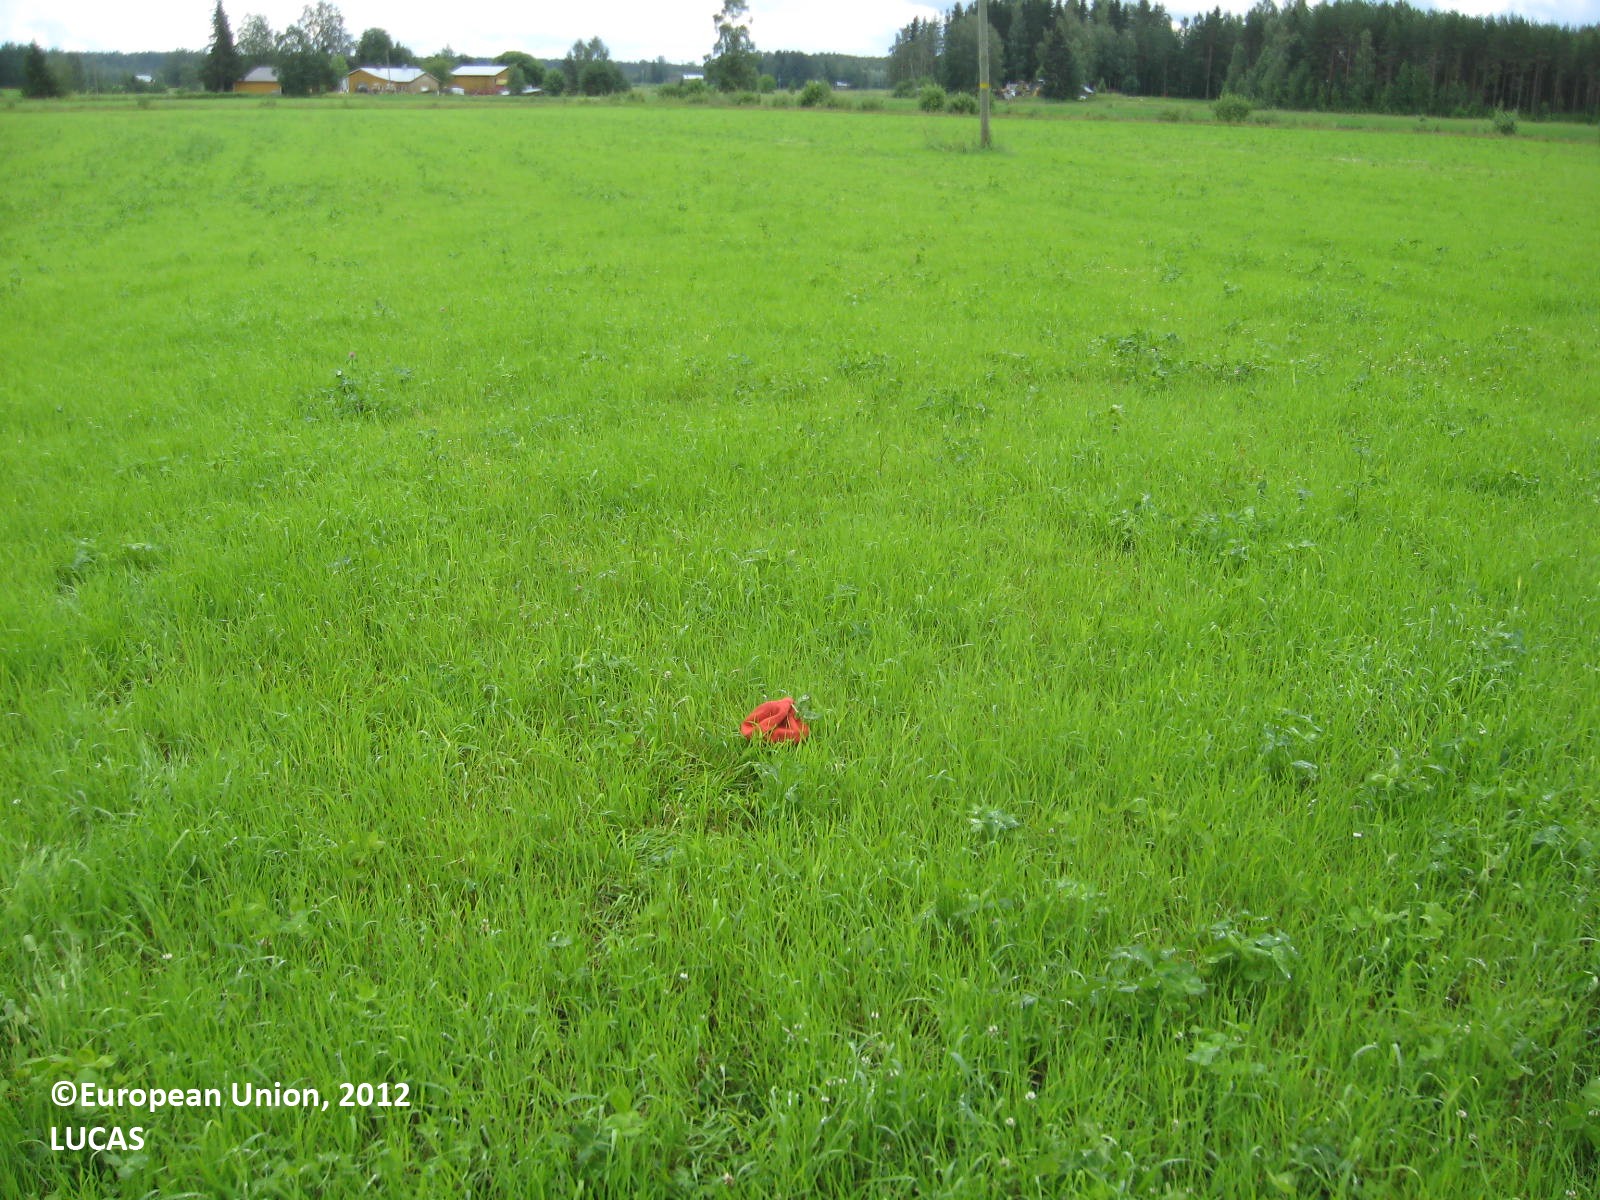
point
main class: Cropland
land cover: Temporary grasslands
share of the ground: > 75 %
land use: Agriculture (excluding fallow land and kitchen gardens)
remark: Harvested field
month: July
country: FI
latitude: 62.3183
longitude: 22.8159
